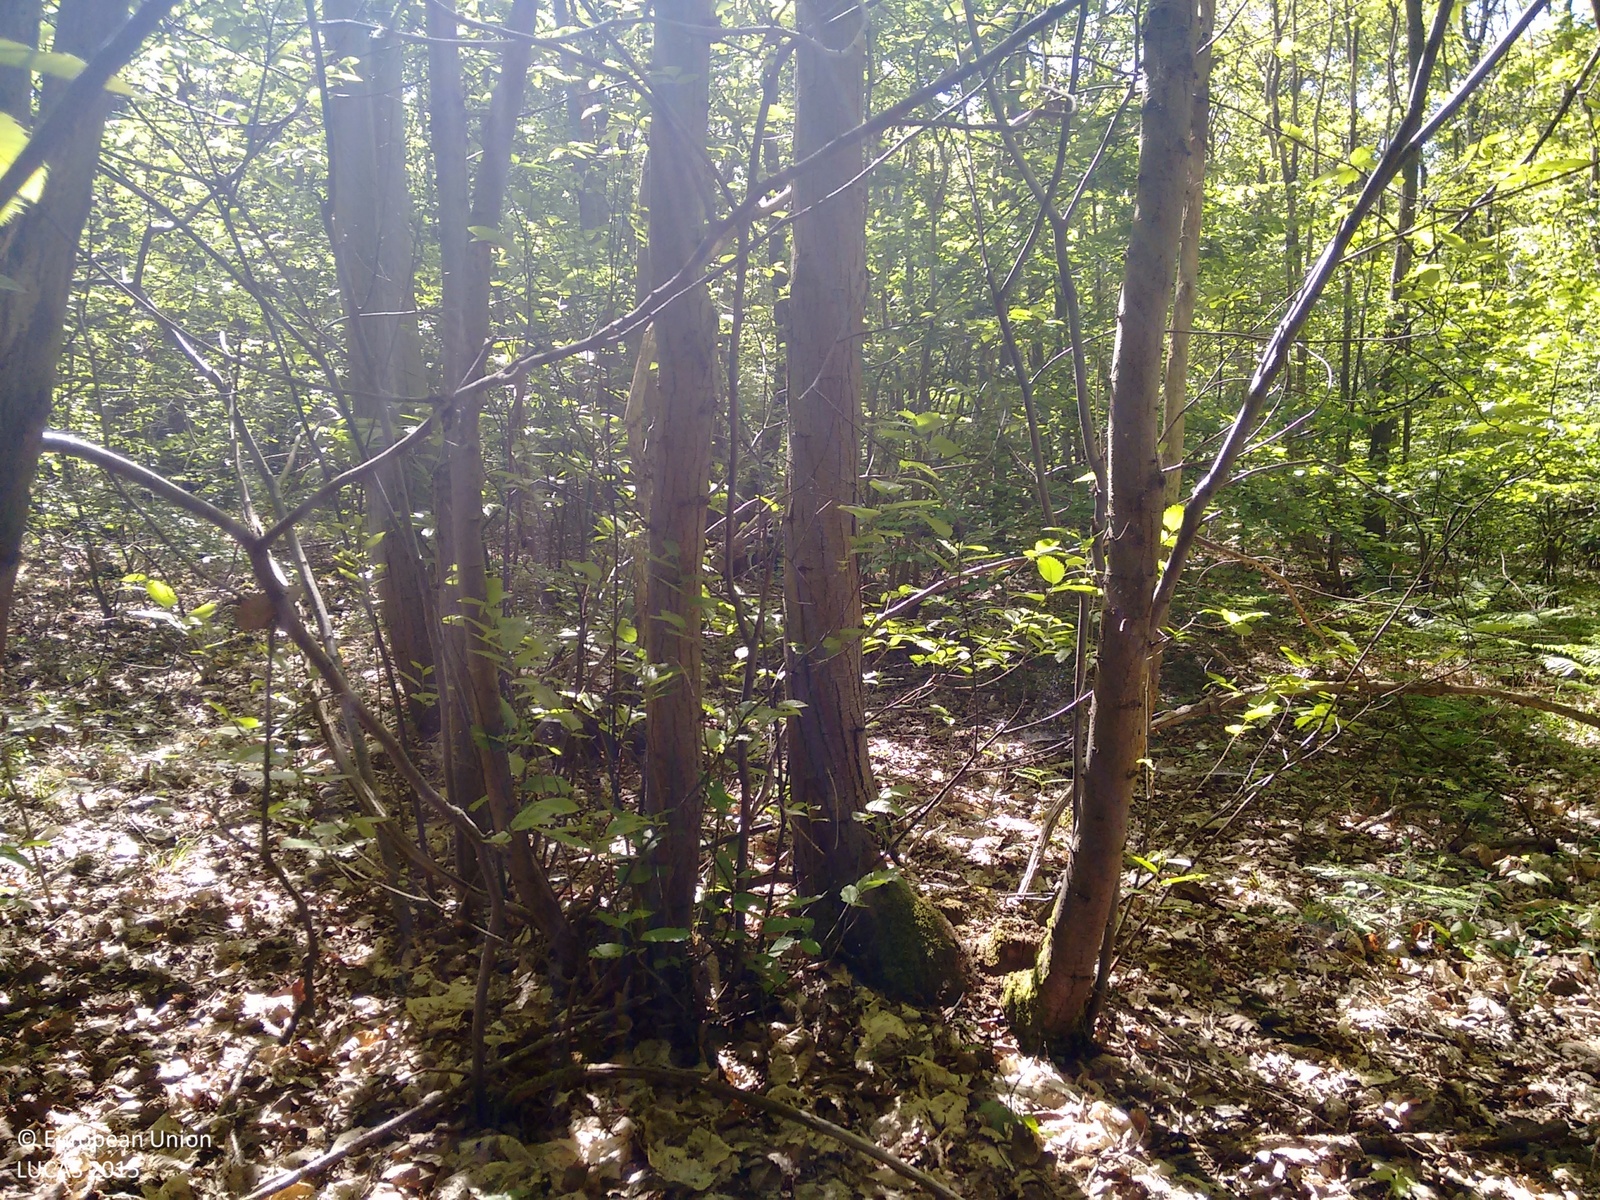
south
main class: Woodland
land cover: Broadleaved woodland
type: mesophytic deciduous forest
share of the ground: > 75 %
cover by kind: broadleaved forest trees 80 %, shrubs 20 %
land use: Forestry
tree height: > 5 m
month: May
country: GB
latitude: 51.3344
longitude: 1.0637
